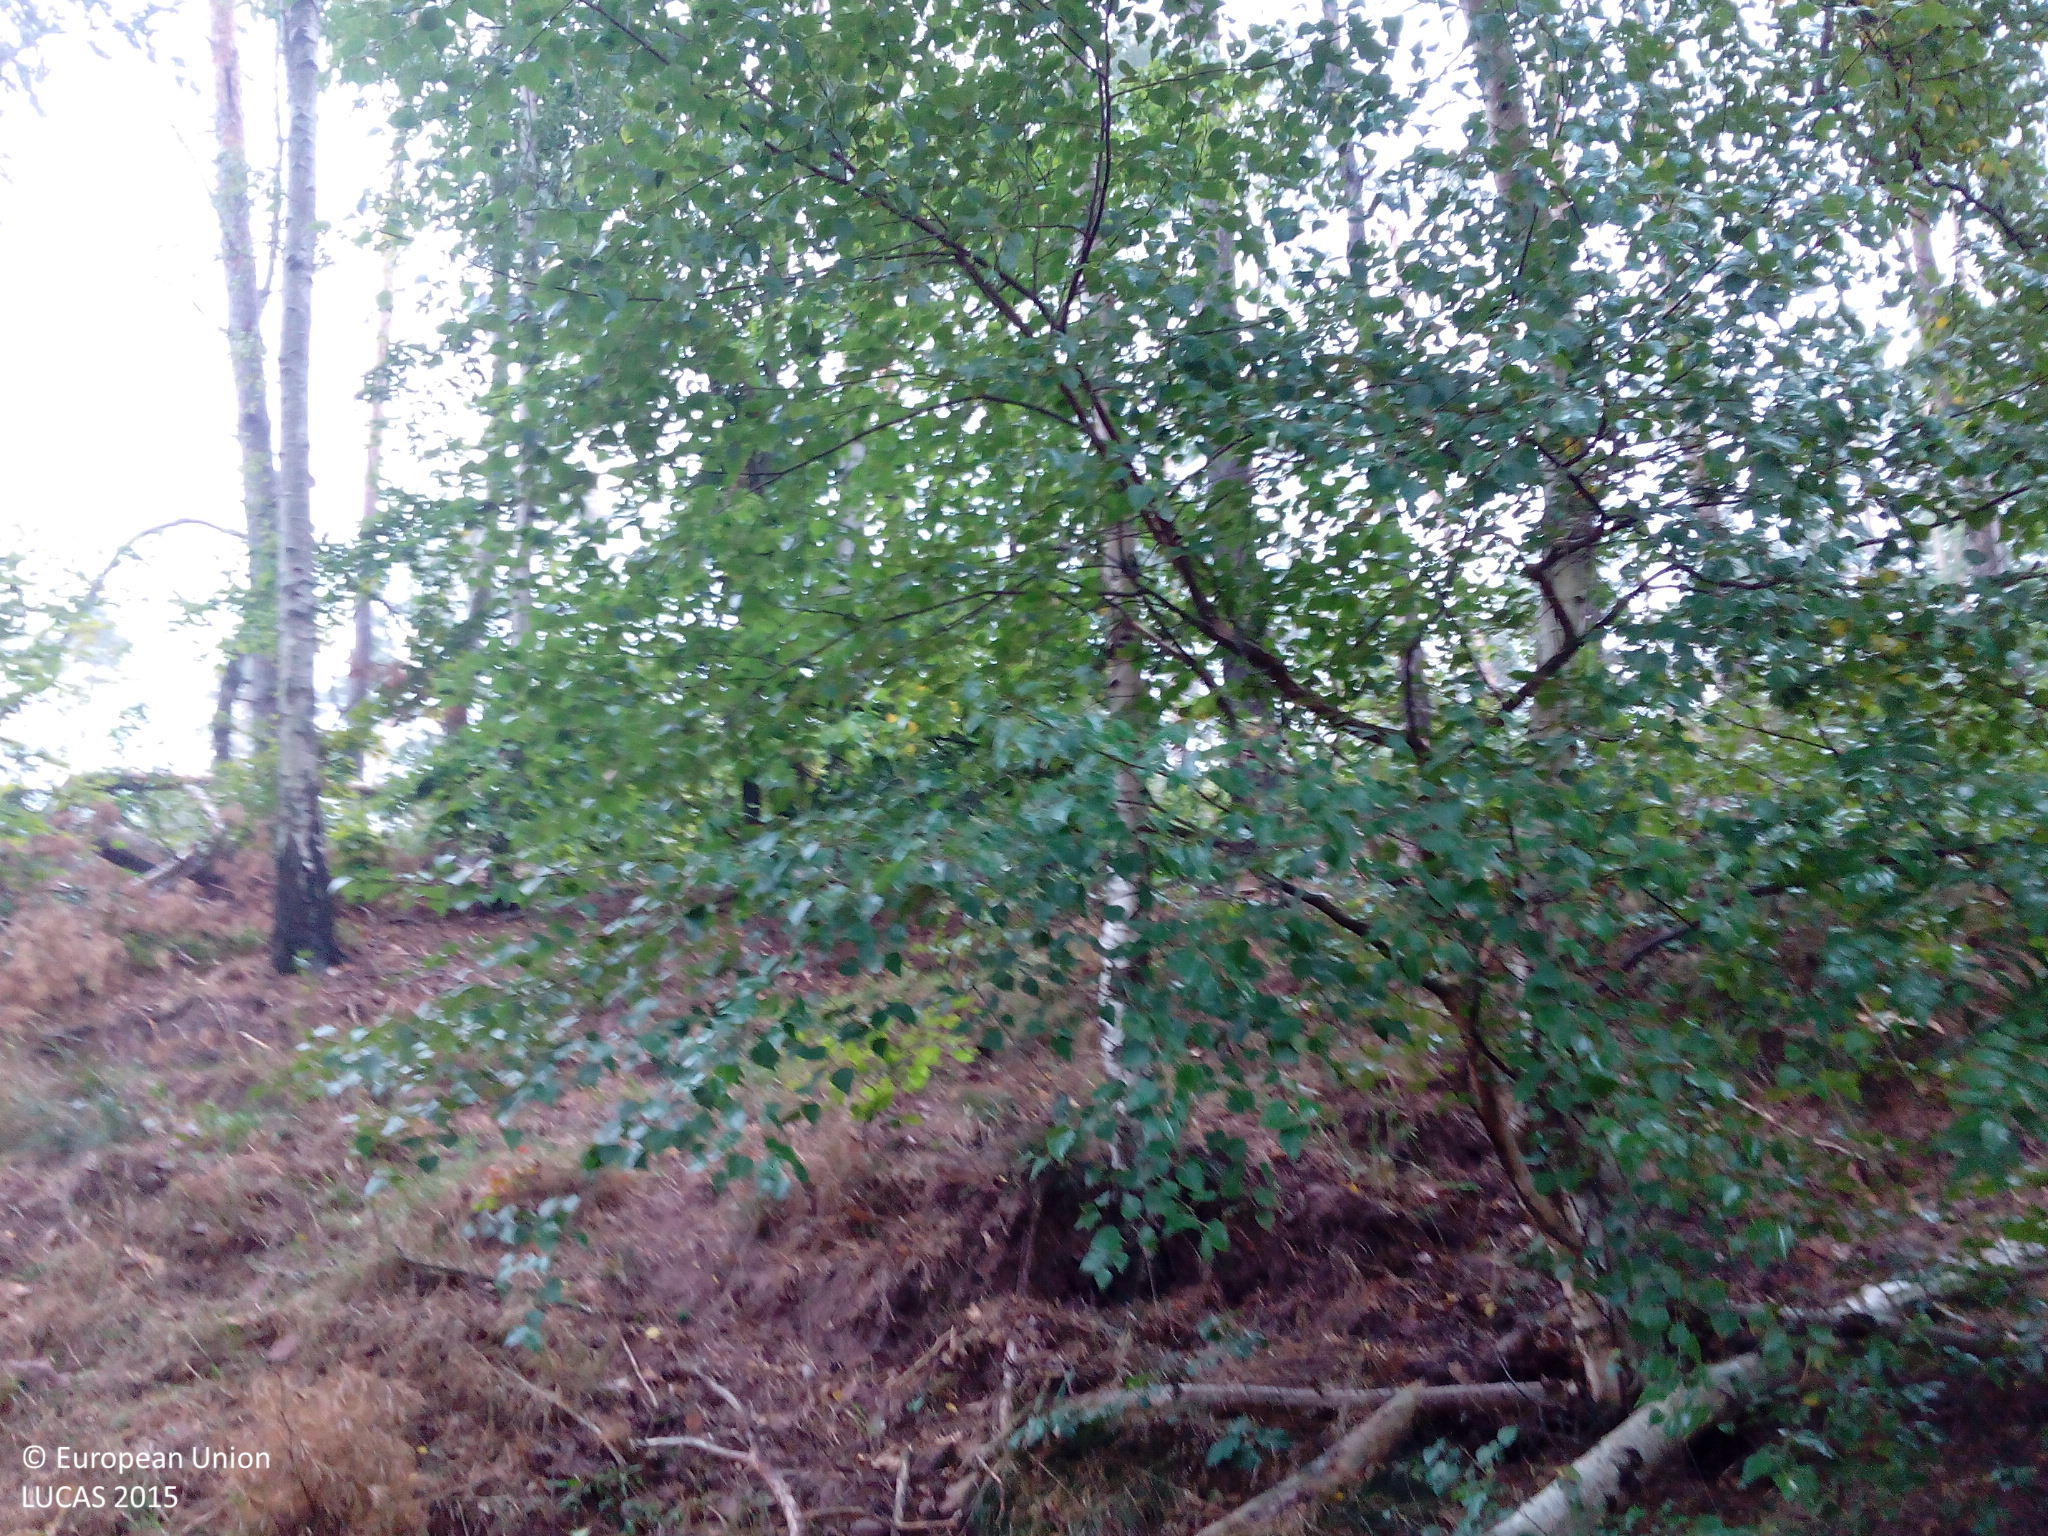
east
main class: Woodland
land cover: Pine dominated mixed woodland
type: hemiboreal forest and nemoral coniferous forest and mixed broadleaved-coniferous forest
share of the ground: > 75 %
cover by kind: coniferous forest trees 75 %, broadleaved forest trees 25 %
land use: Forestry
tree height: > 5 m
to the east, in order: Pine dominated mixed woodland; Tracks; Grassland with sparse tree/shrub cover; Broadleaved woodland; Tracks; Broadleaved woodland
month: September
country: DE
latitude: 51.4203
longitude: 11.0207
